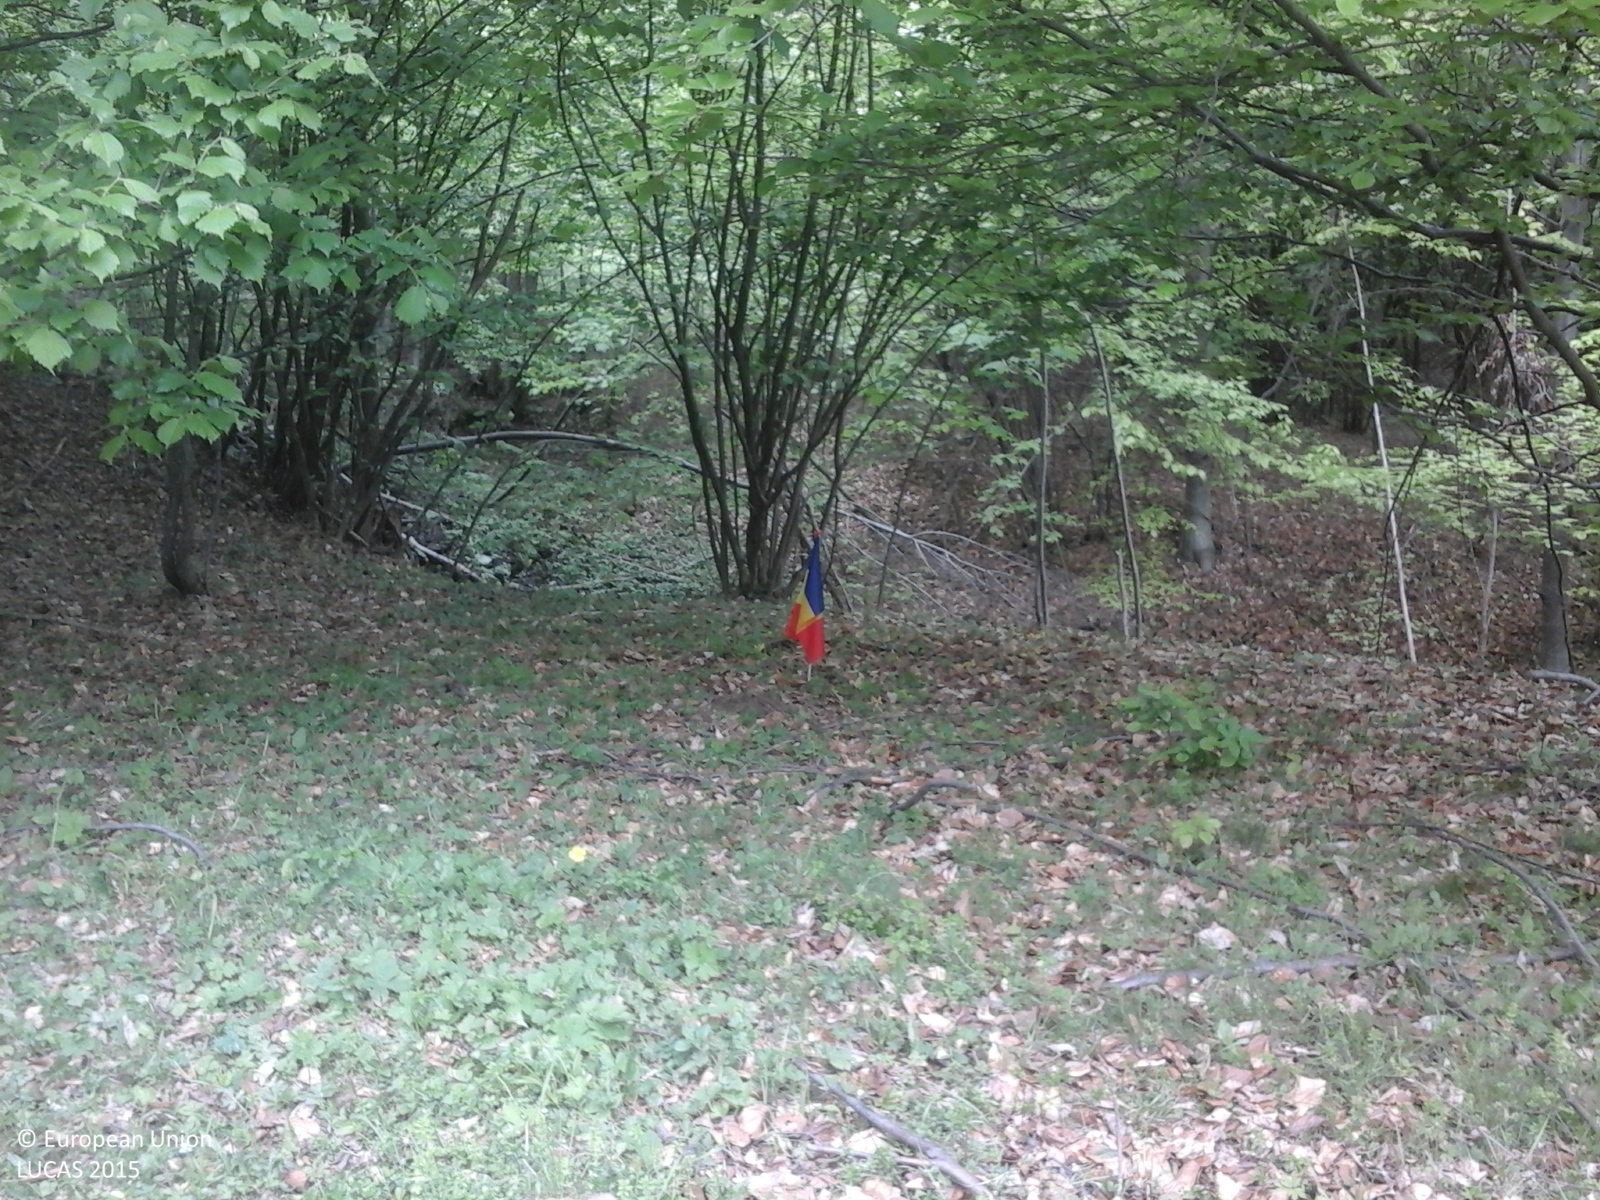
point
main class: Woodland
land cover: Broadleaved woodland
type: beech forest
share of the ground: > 75 %
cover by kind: broadleaved forest trees 100 %
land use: Forestry
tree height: > 5 m
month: May
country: RO
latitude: 45.5900
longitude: 25.9162
